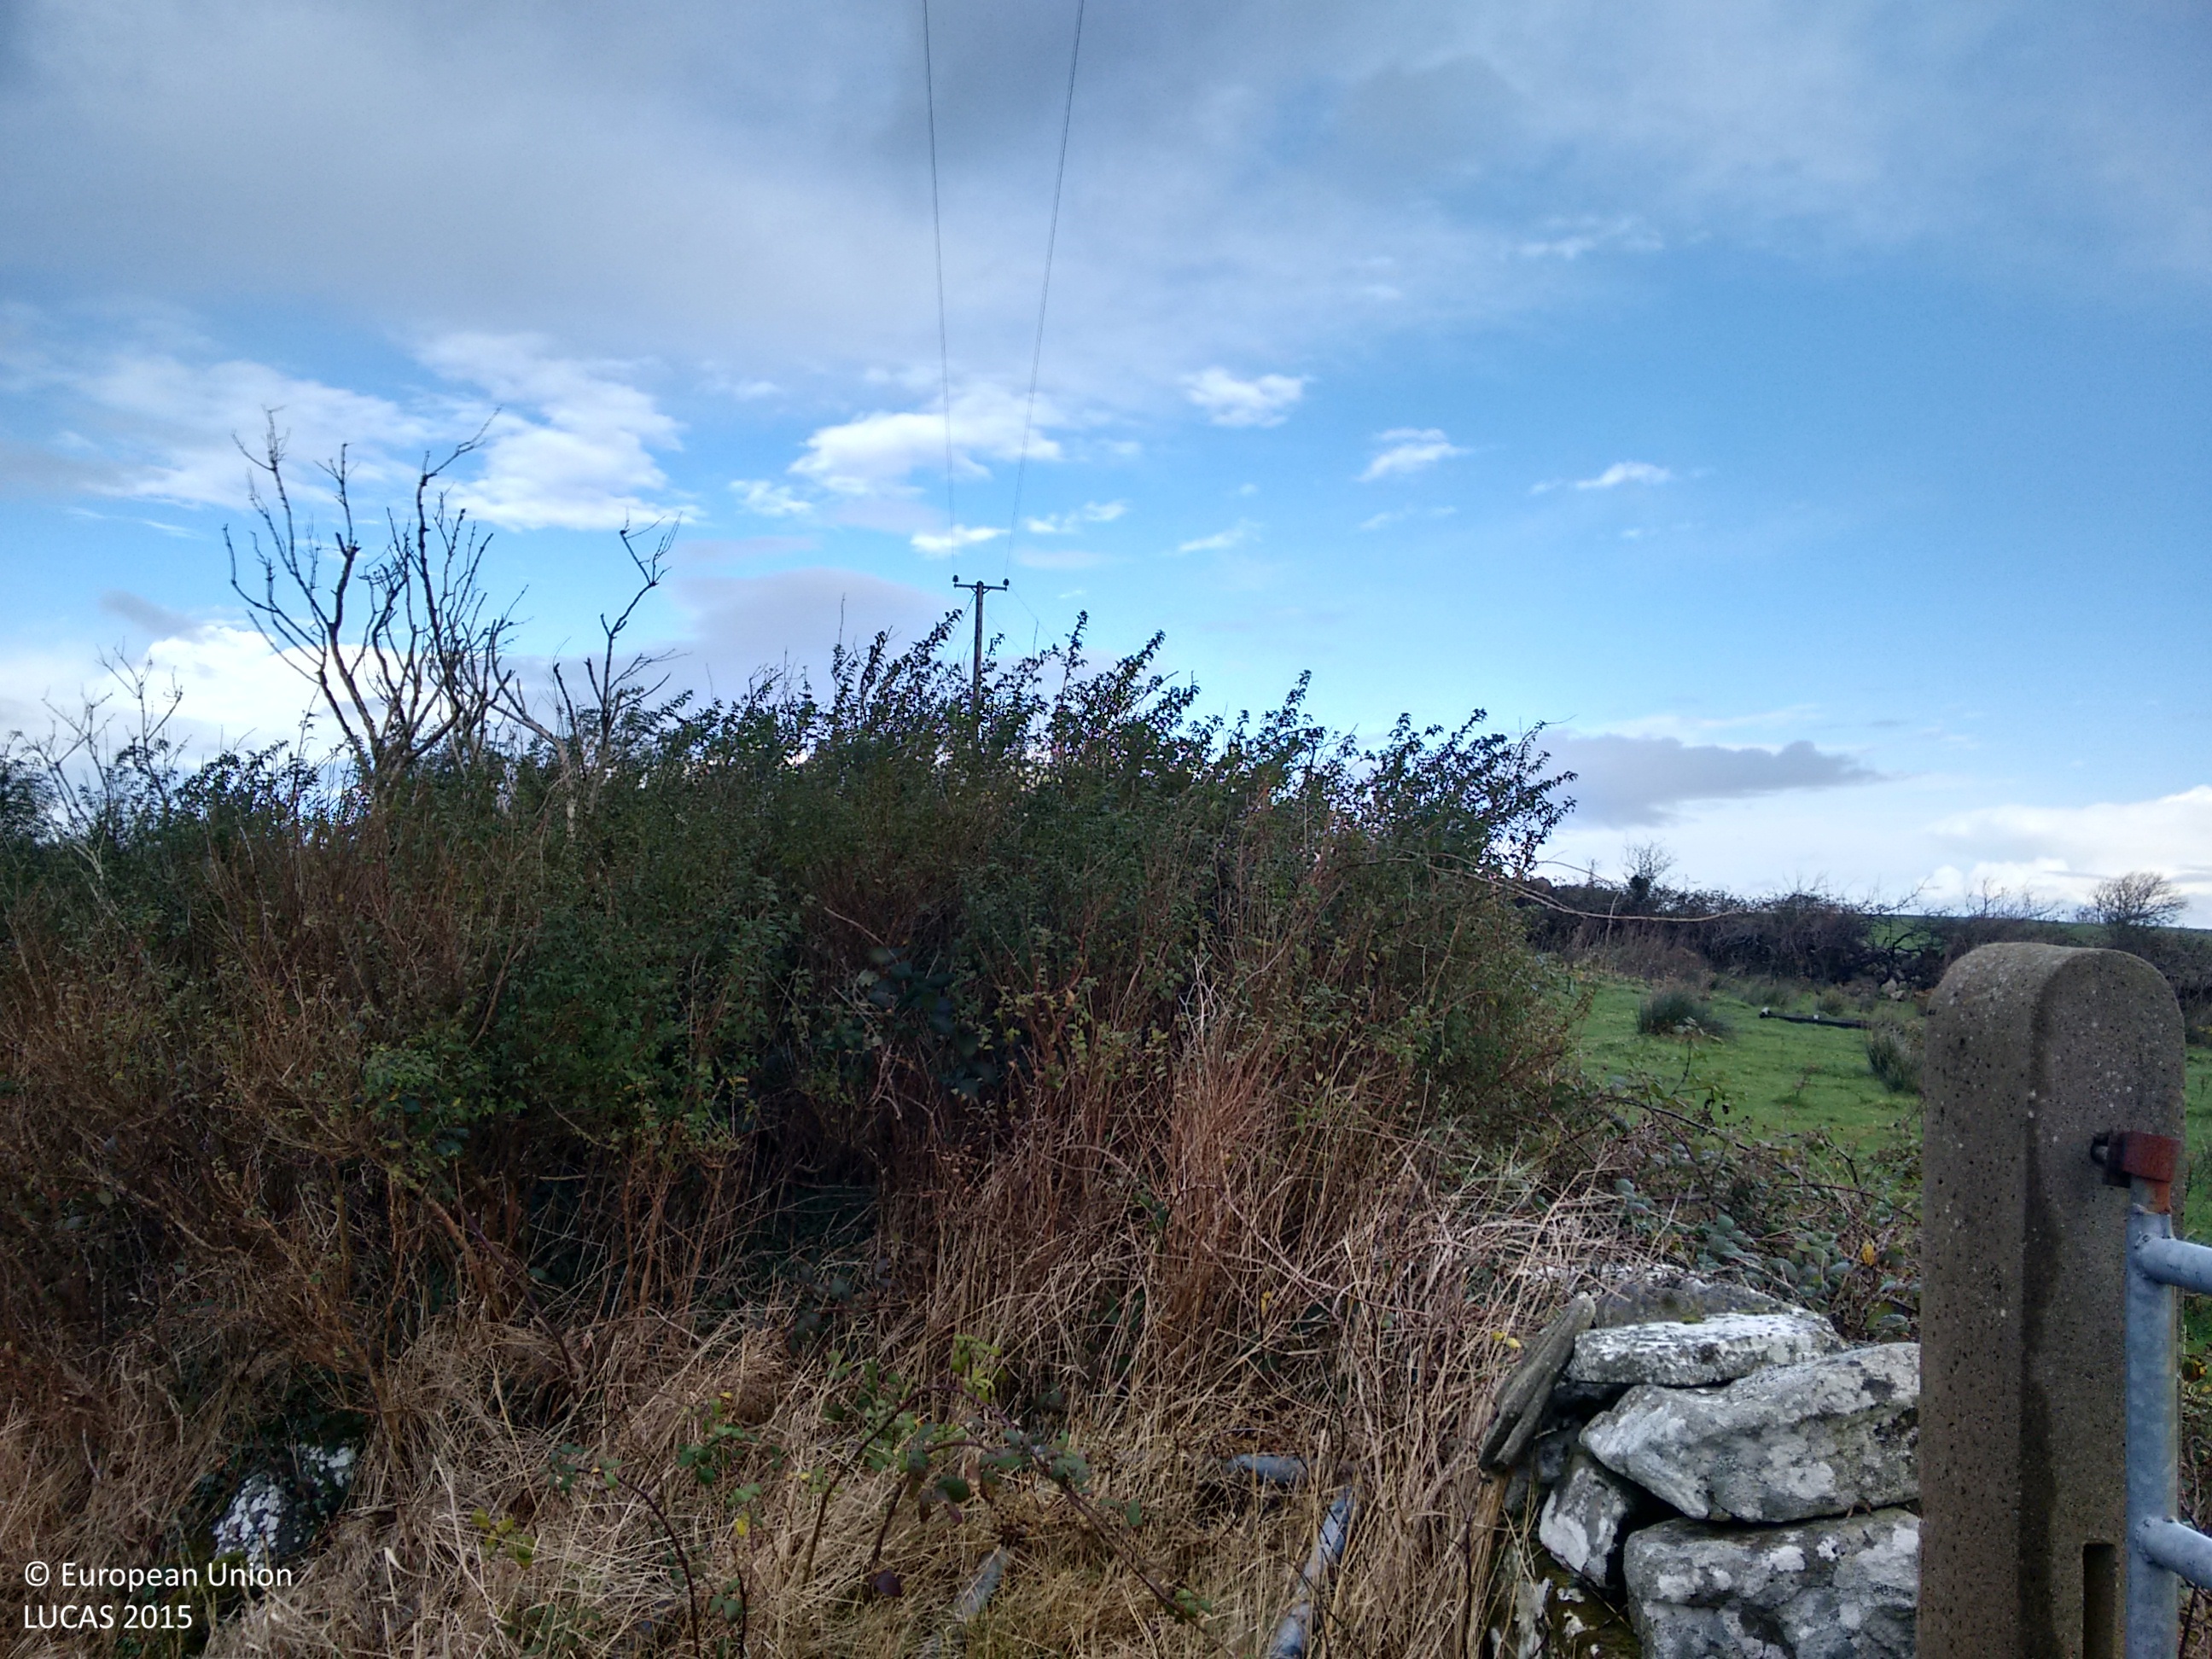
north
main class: Grassland
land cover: Grassland without tree/shrub cover
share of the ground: > 75 %
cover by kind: herbaceous plants 100 %
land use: Agriculture (excluding fallow land and kitchen gardens)
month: November
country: IE
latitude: 54.4590
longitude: -8.3417
